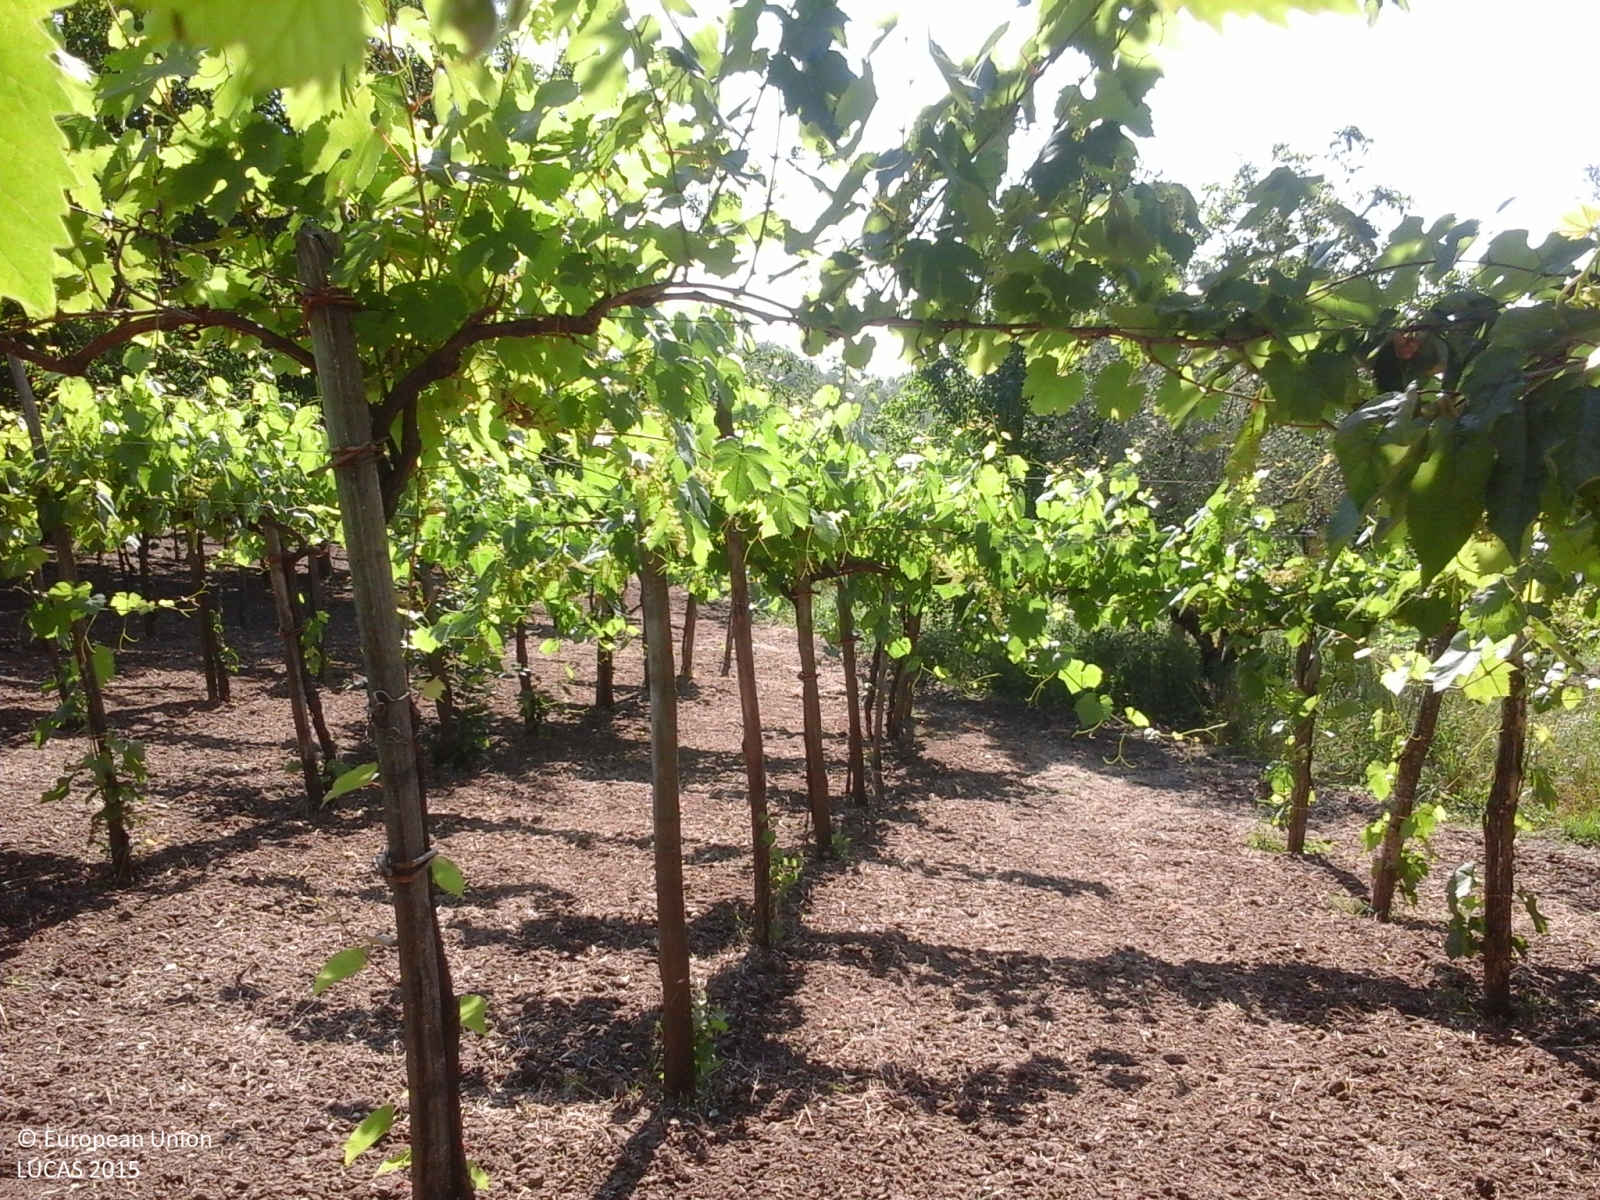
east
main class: Cropland
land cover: Vineyards
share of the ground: > 75 %
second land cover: Other bare soil
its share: > 75 %
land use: Agriculture (excluding fallow land and kitchen gardens)
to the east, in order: Vineyards; Other bare soil; Grass margins; Tracks; Grassland without tree/shrub cover; Grassland with sparse tree/shrub cover; Grass margins; Ditches and canals; Shruby margins; Tracks; Vineyards; Olive groves; Artificial constructions in urban areas; Grass margins; Olive groves; Grass margins; Vineyards; Electric lines; Vineyards; Abandoned hedges; Grass margins; Paved roads, cycling and walking lanes; Grass margins; Artificial constructions; Electric lines; Olive groves
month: June
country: IT
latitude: 41.1698
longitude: 14.6903
